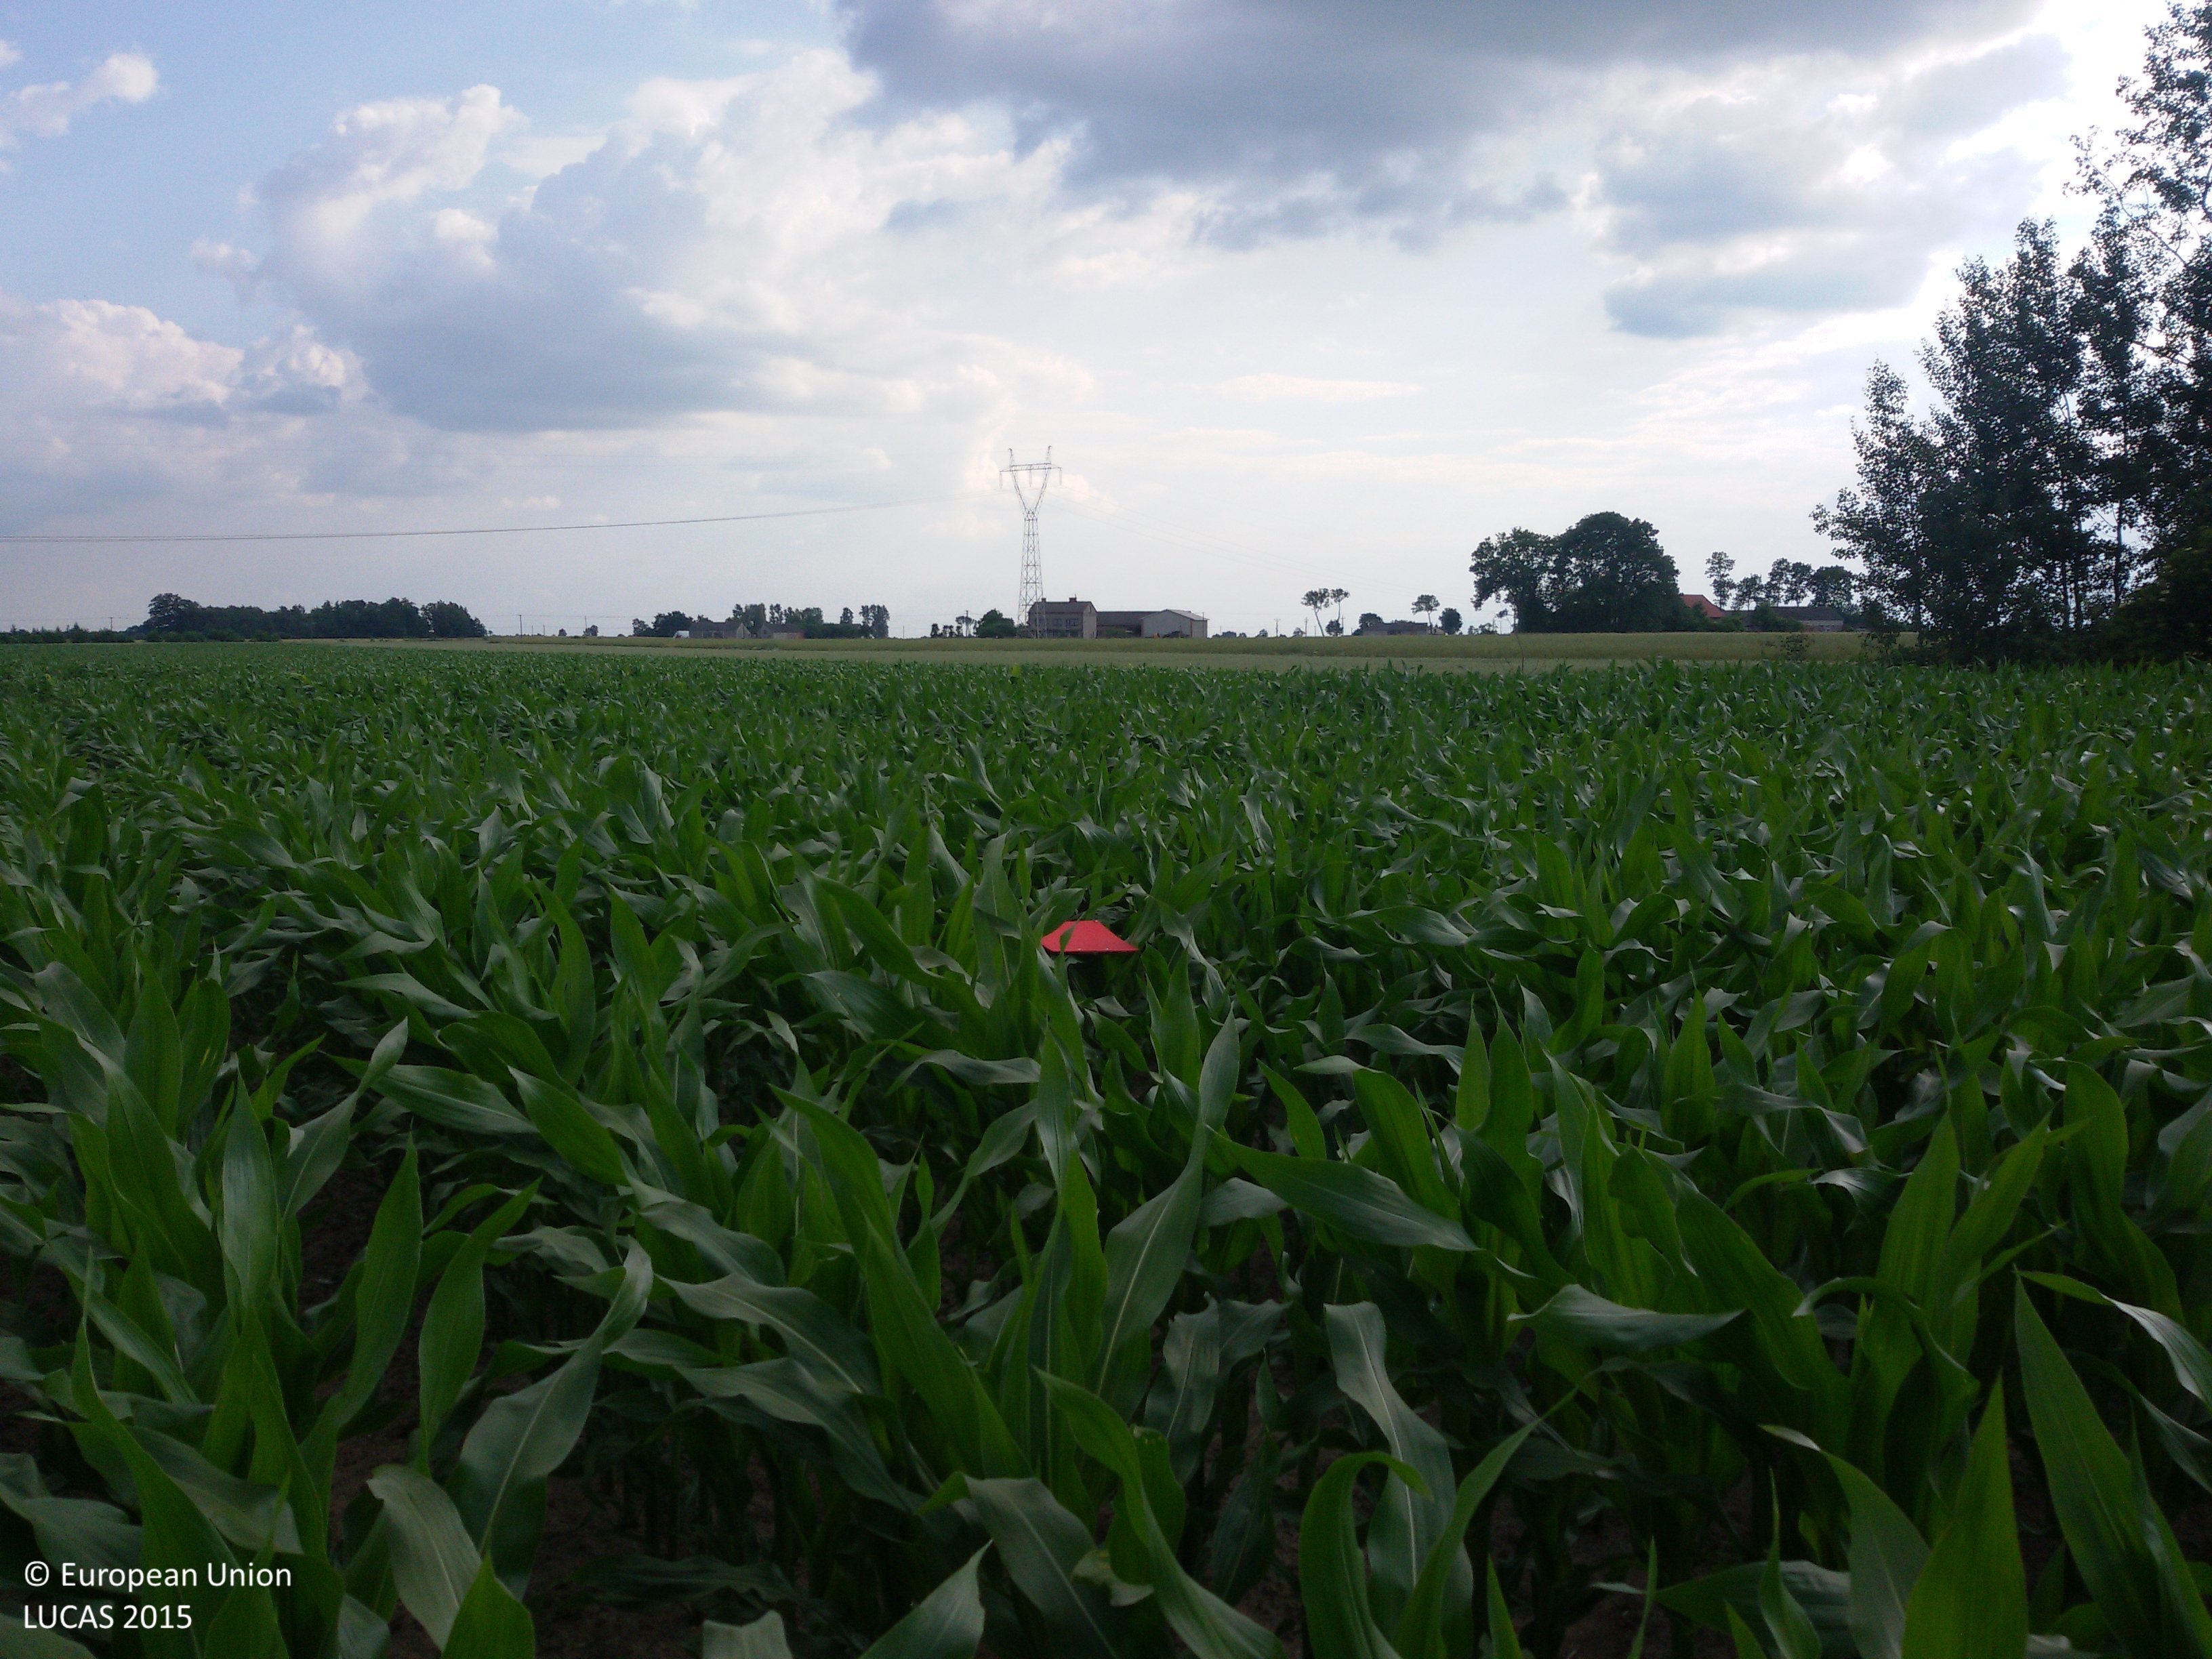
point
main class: Cropland
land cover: Maize
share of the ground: > 75 %
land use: Agriculture (excluding fallow land and kitchen gardens)
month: June
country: PL
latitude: 52.2760
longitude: 19.8360
